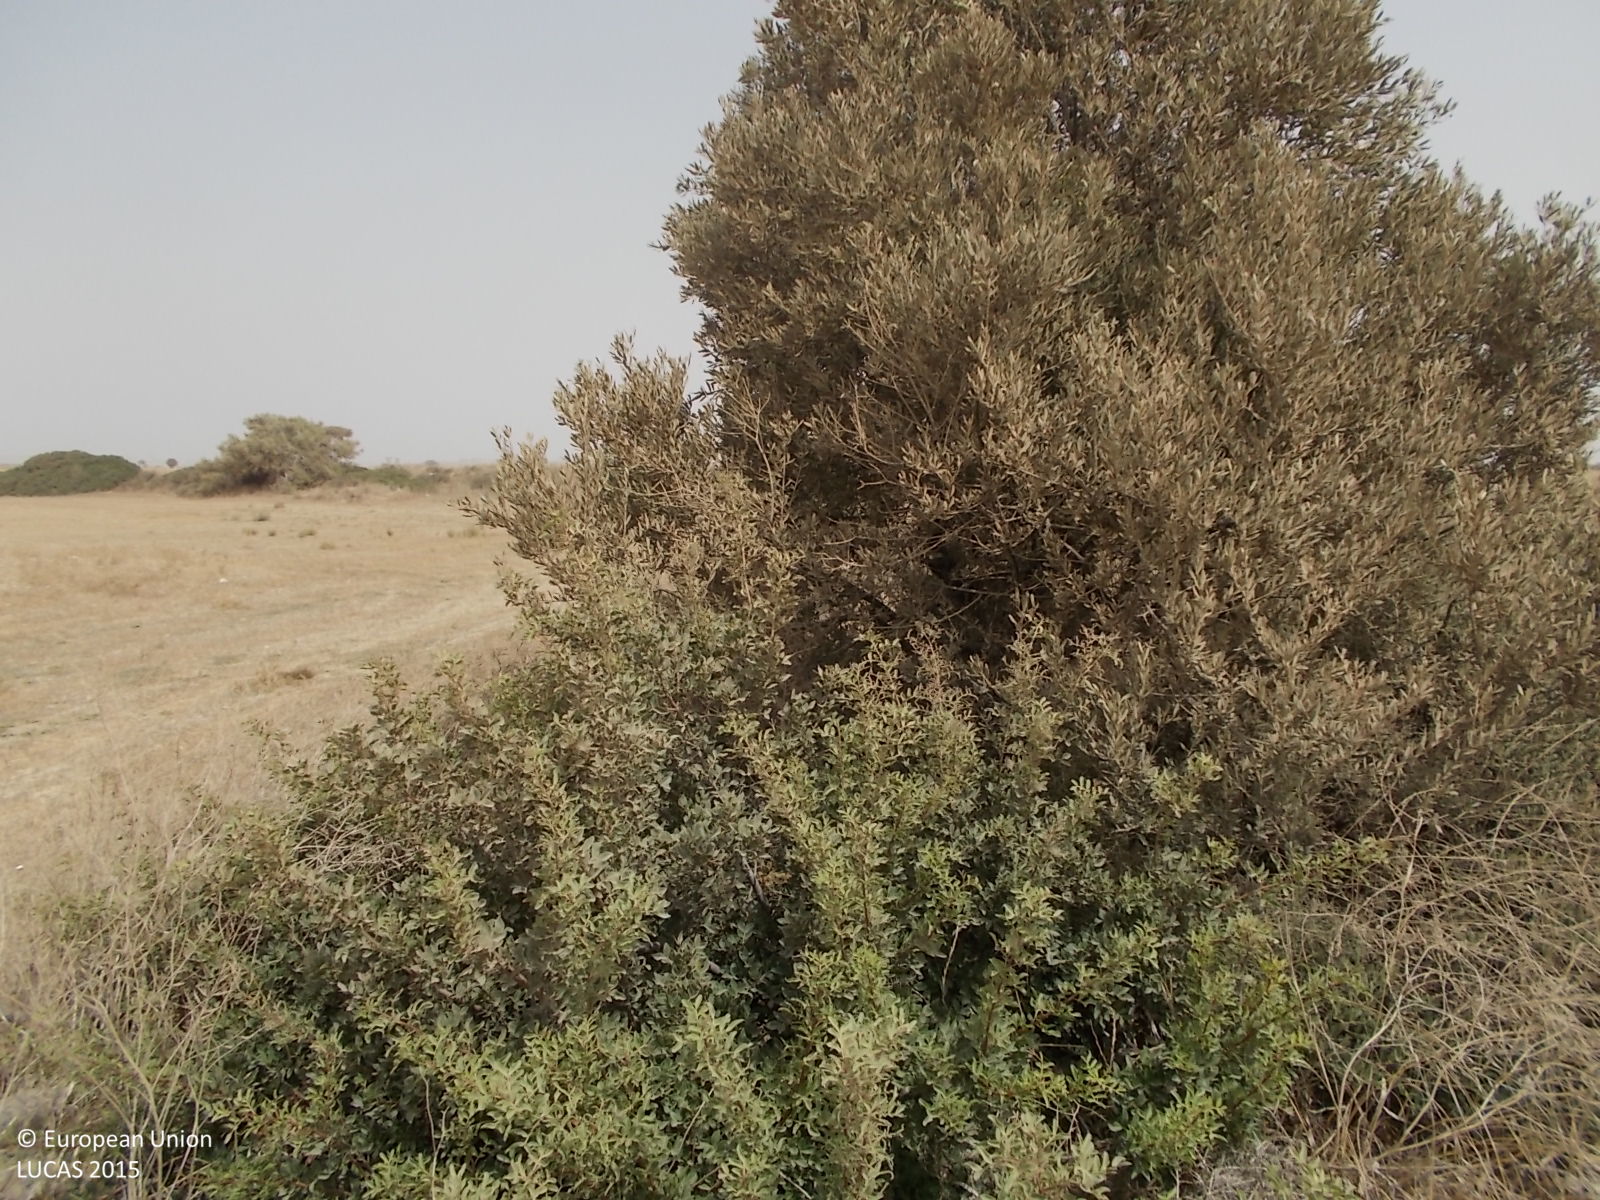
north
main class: Shrubland
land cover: Shrubland with sparse tree cover
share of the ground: 50 - 75 %
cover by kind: shrubs 55 %, herbaceous plants 20 %, unconsolidated bare surface 15 %, broadleaved forest trees 5 %, consolidated bare surface 5 %
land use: Semi-natural and natural areas not in use
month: April
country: CY
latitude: 34.8133
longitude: 33.5057
